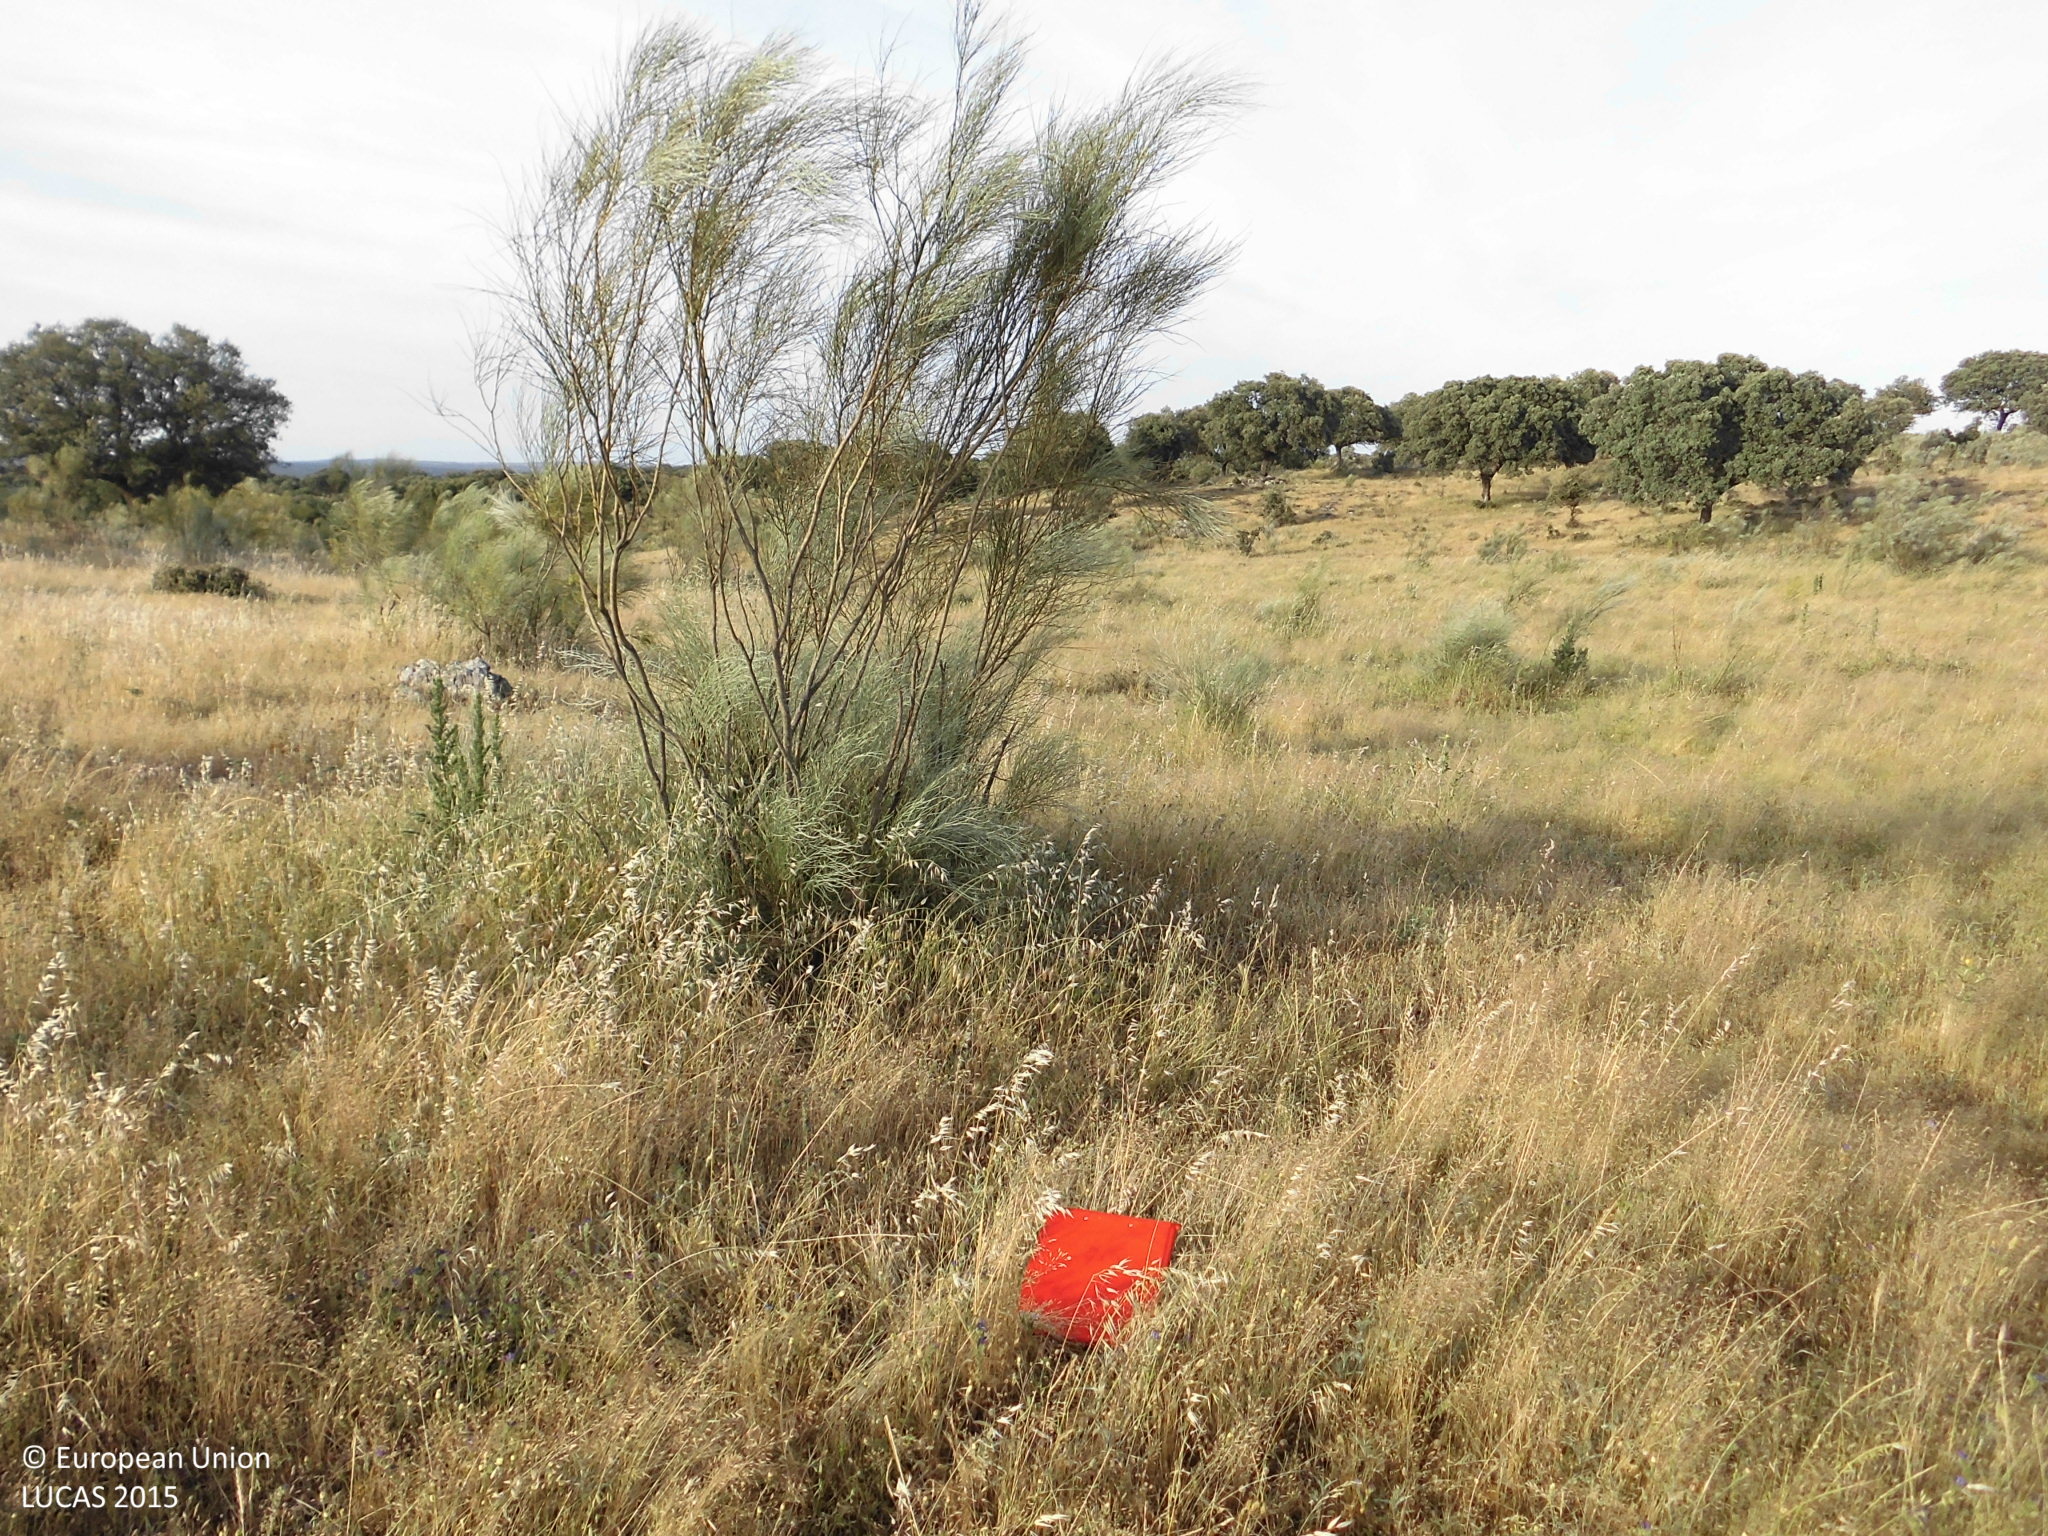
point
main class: Shrubland
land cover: Shrubland without tree cover
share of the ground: 10 - 25 %
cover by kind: herbaceous plants 90 %, shrubs 10 %
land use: Agriculture (excluding fallow land and kitchen gardens)
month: May
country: ES
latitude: 39.5693
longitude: -6.1167
